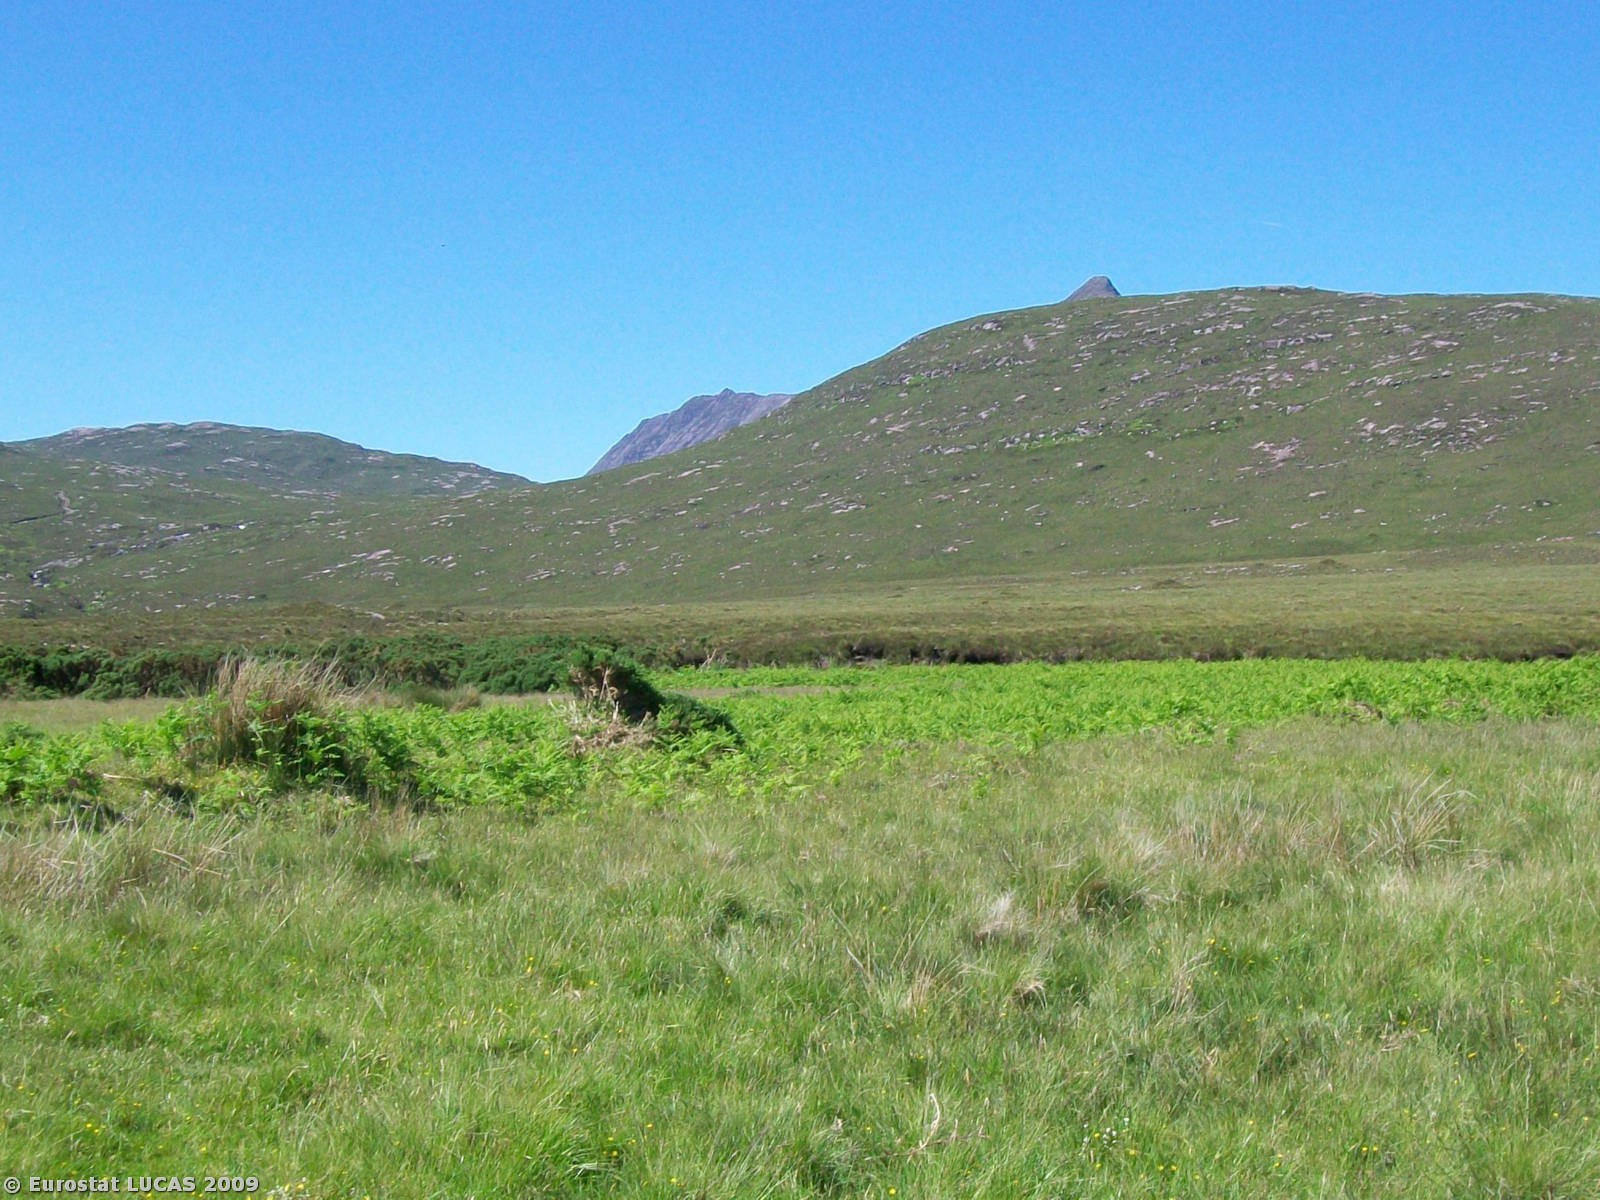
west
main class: Grassland
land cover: Grassland without tree/shrub cover
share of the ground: > 75 %
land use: Fallow land
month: June
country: GB
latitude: 57.9790
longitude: -5.1355
